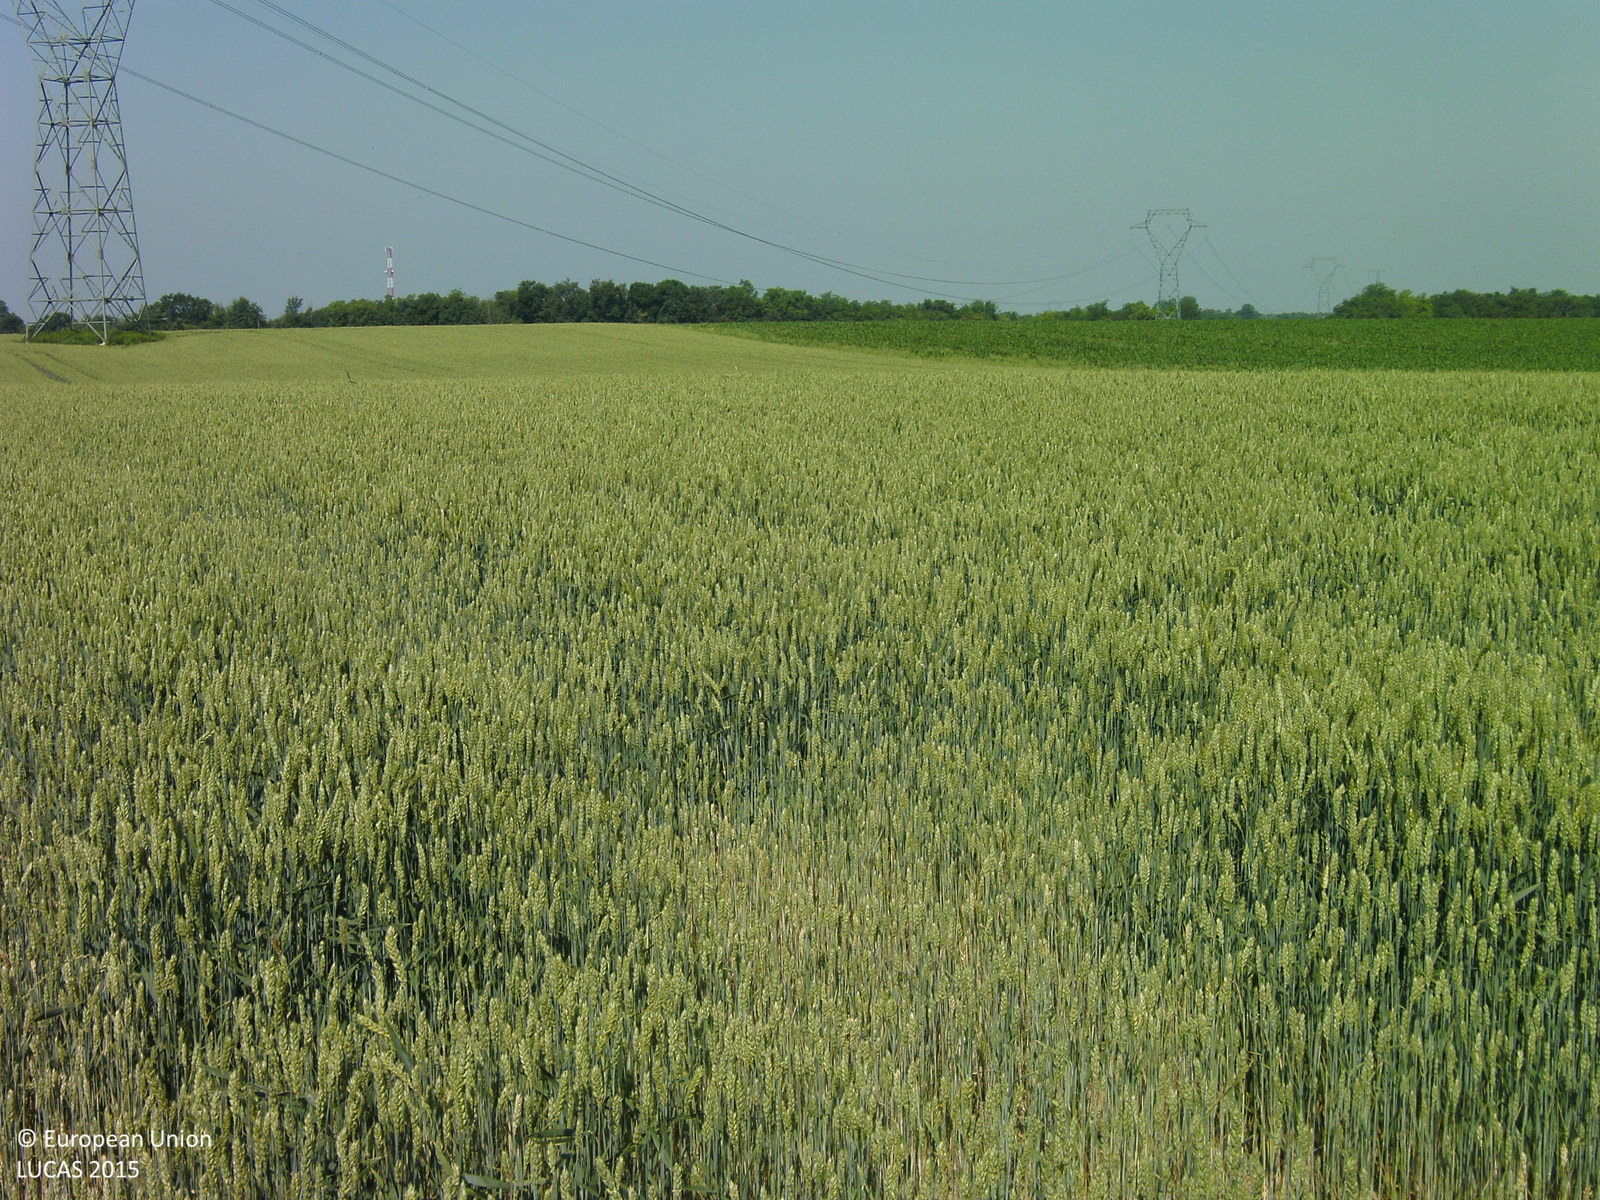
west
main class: Cropland
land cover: Common wheat
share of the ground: > 75 %
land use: Agriculture (excluding fallow land and kitchen gardens)
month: June
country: HU
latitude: 46.4730
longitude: 17.6767
